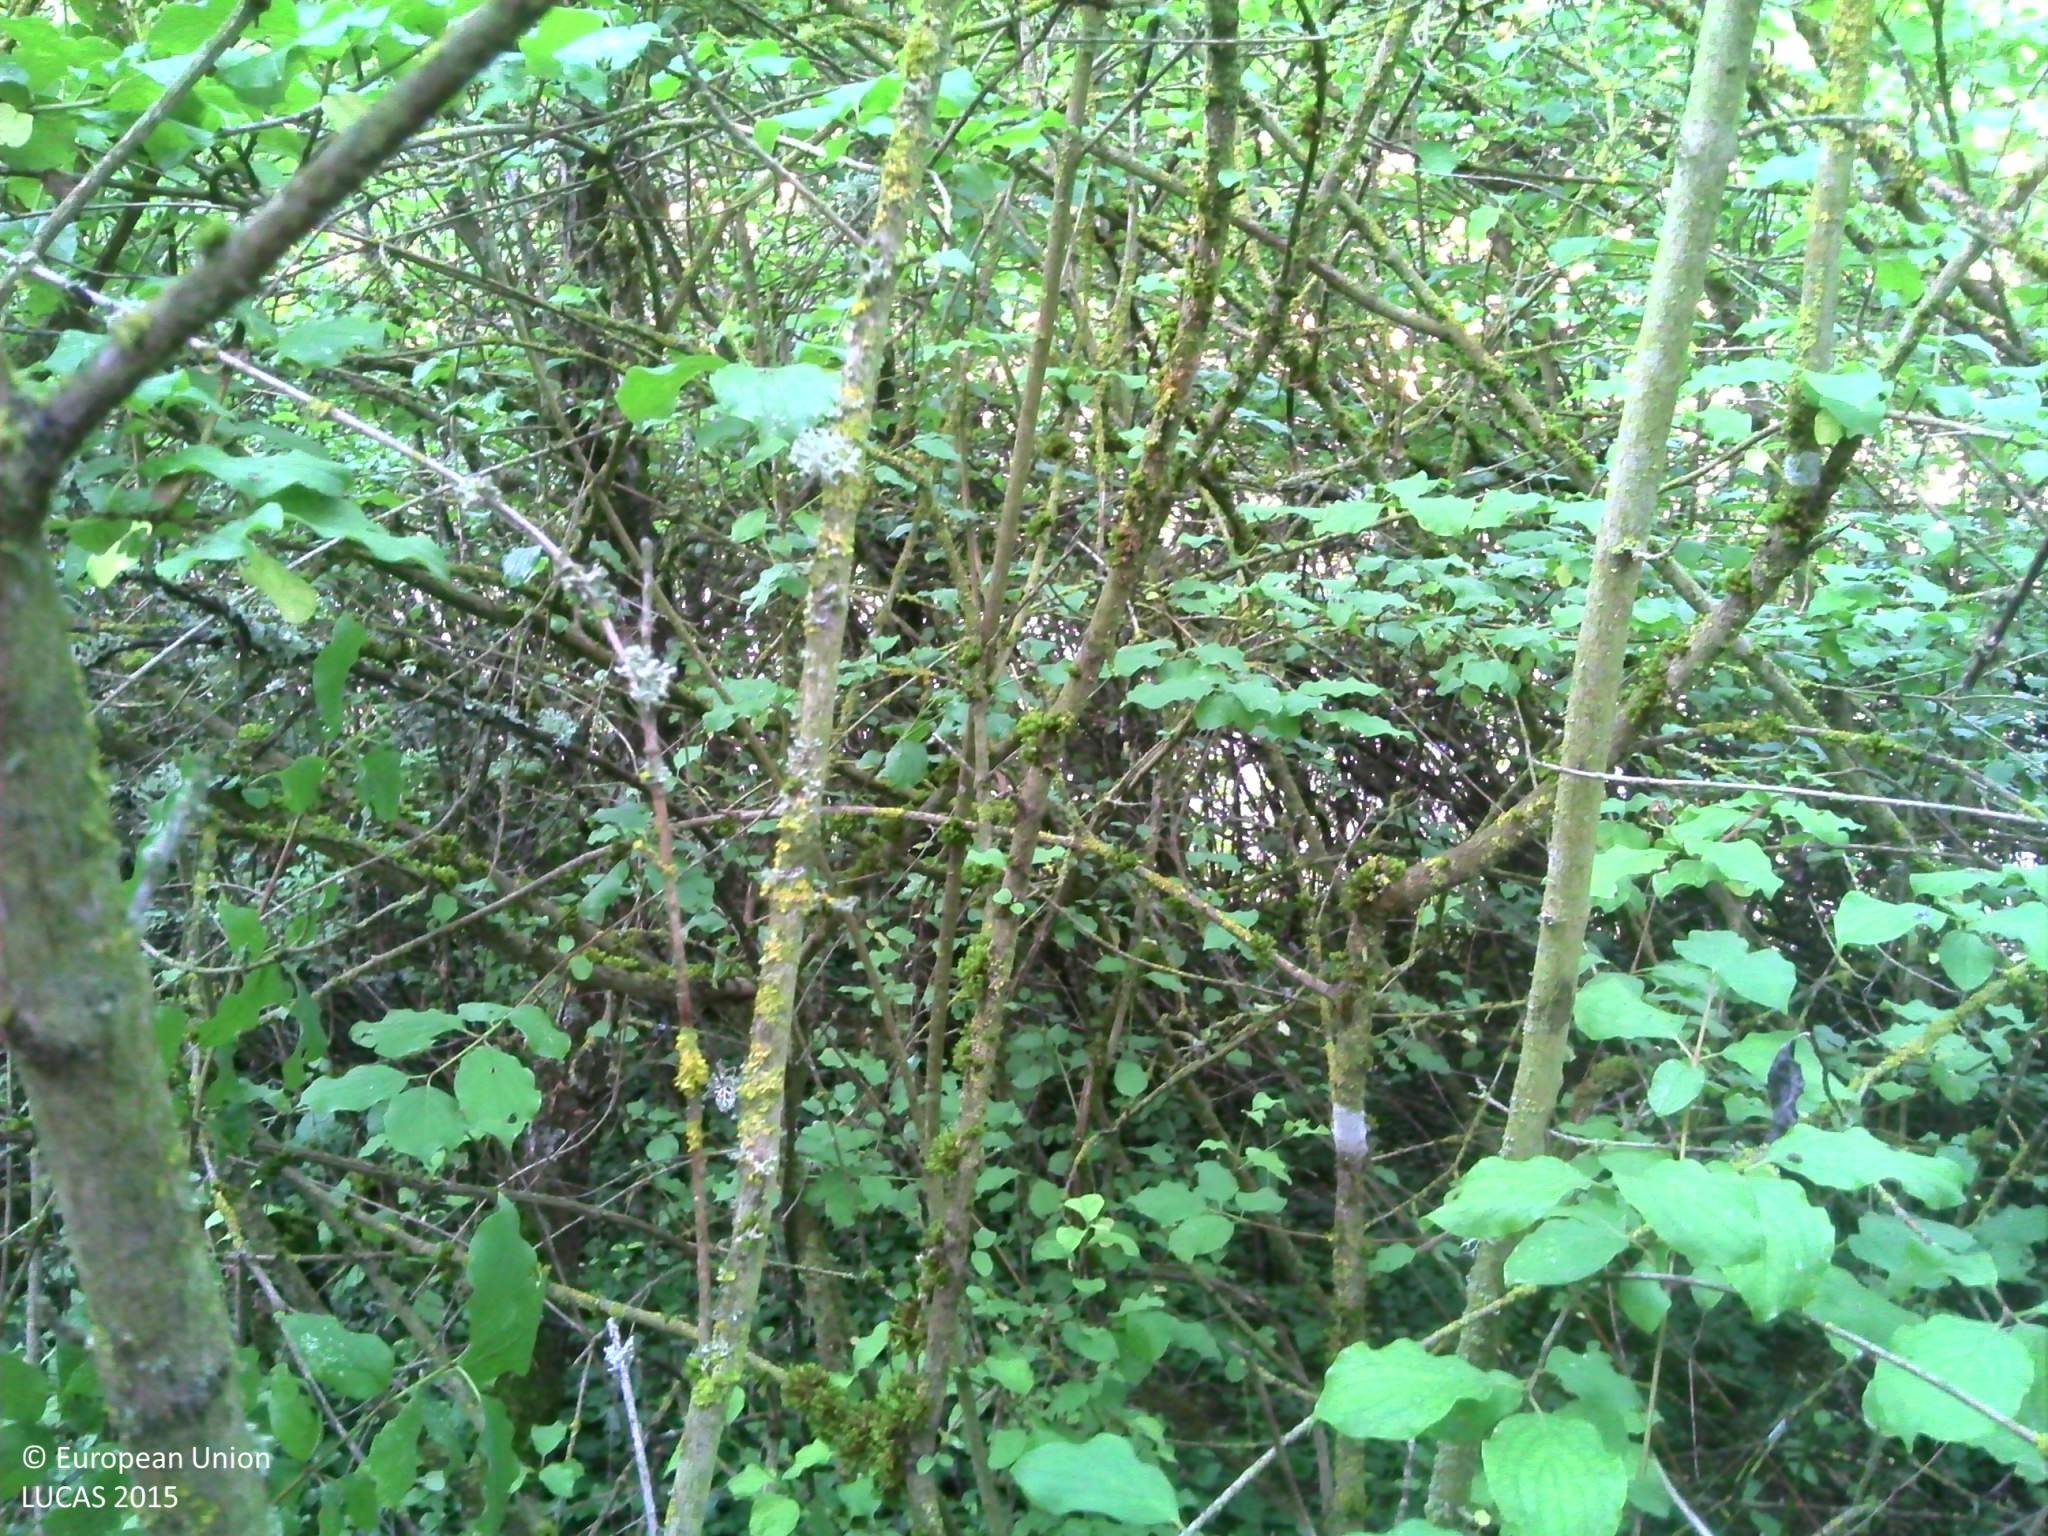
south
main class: Woodland
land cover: Pine dominated mixed woodland
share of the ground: > 75 %
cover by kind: broadleaved forest trees 60 %, coniferous forest trees 30 %, herbaceous plants 5 %, lichens and mosses 5 %
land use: Forestry
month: July
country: FR
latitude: 47.7460
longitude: 3.5538
